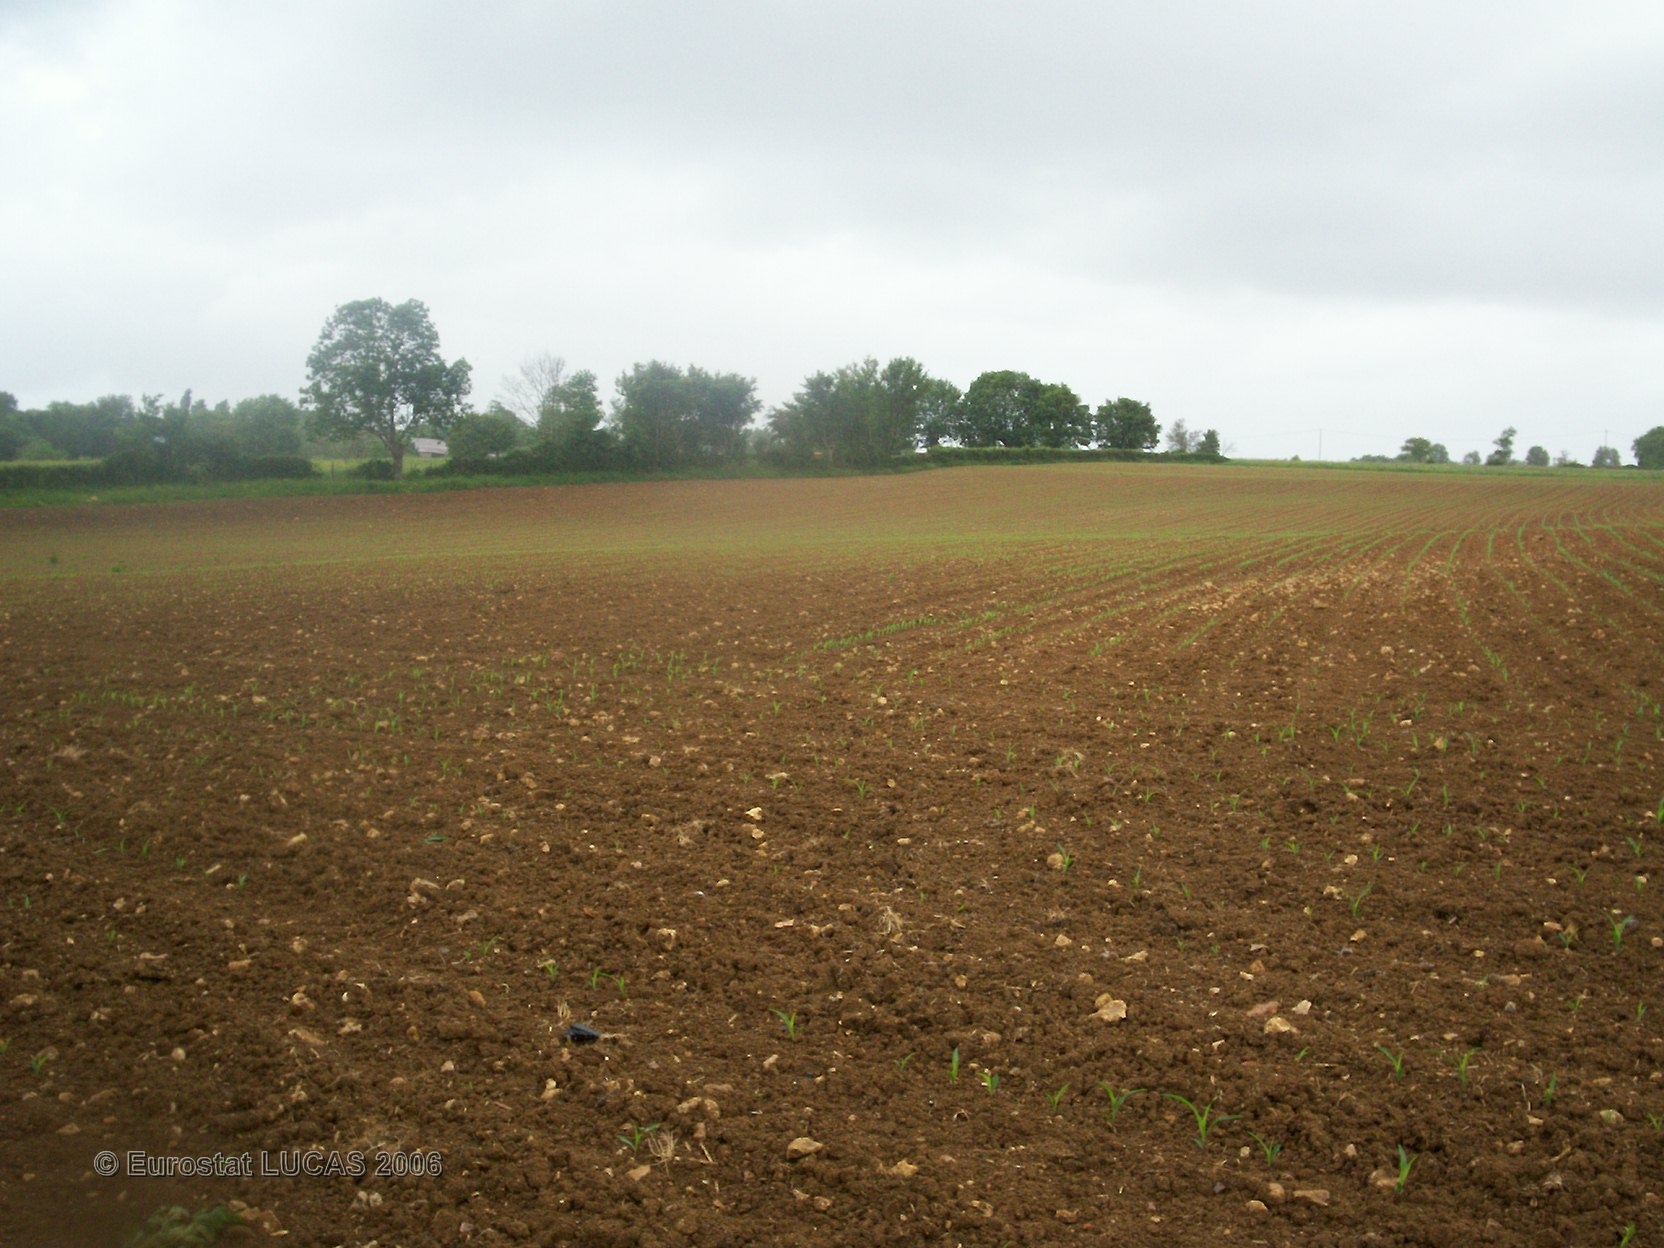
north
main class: Cropland
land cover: Maize
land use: Agriculture (excluding fallow land and kitchen gardens)
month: May
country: FR
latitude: 46.4748
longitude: -0.2479
